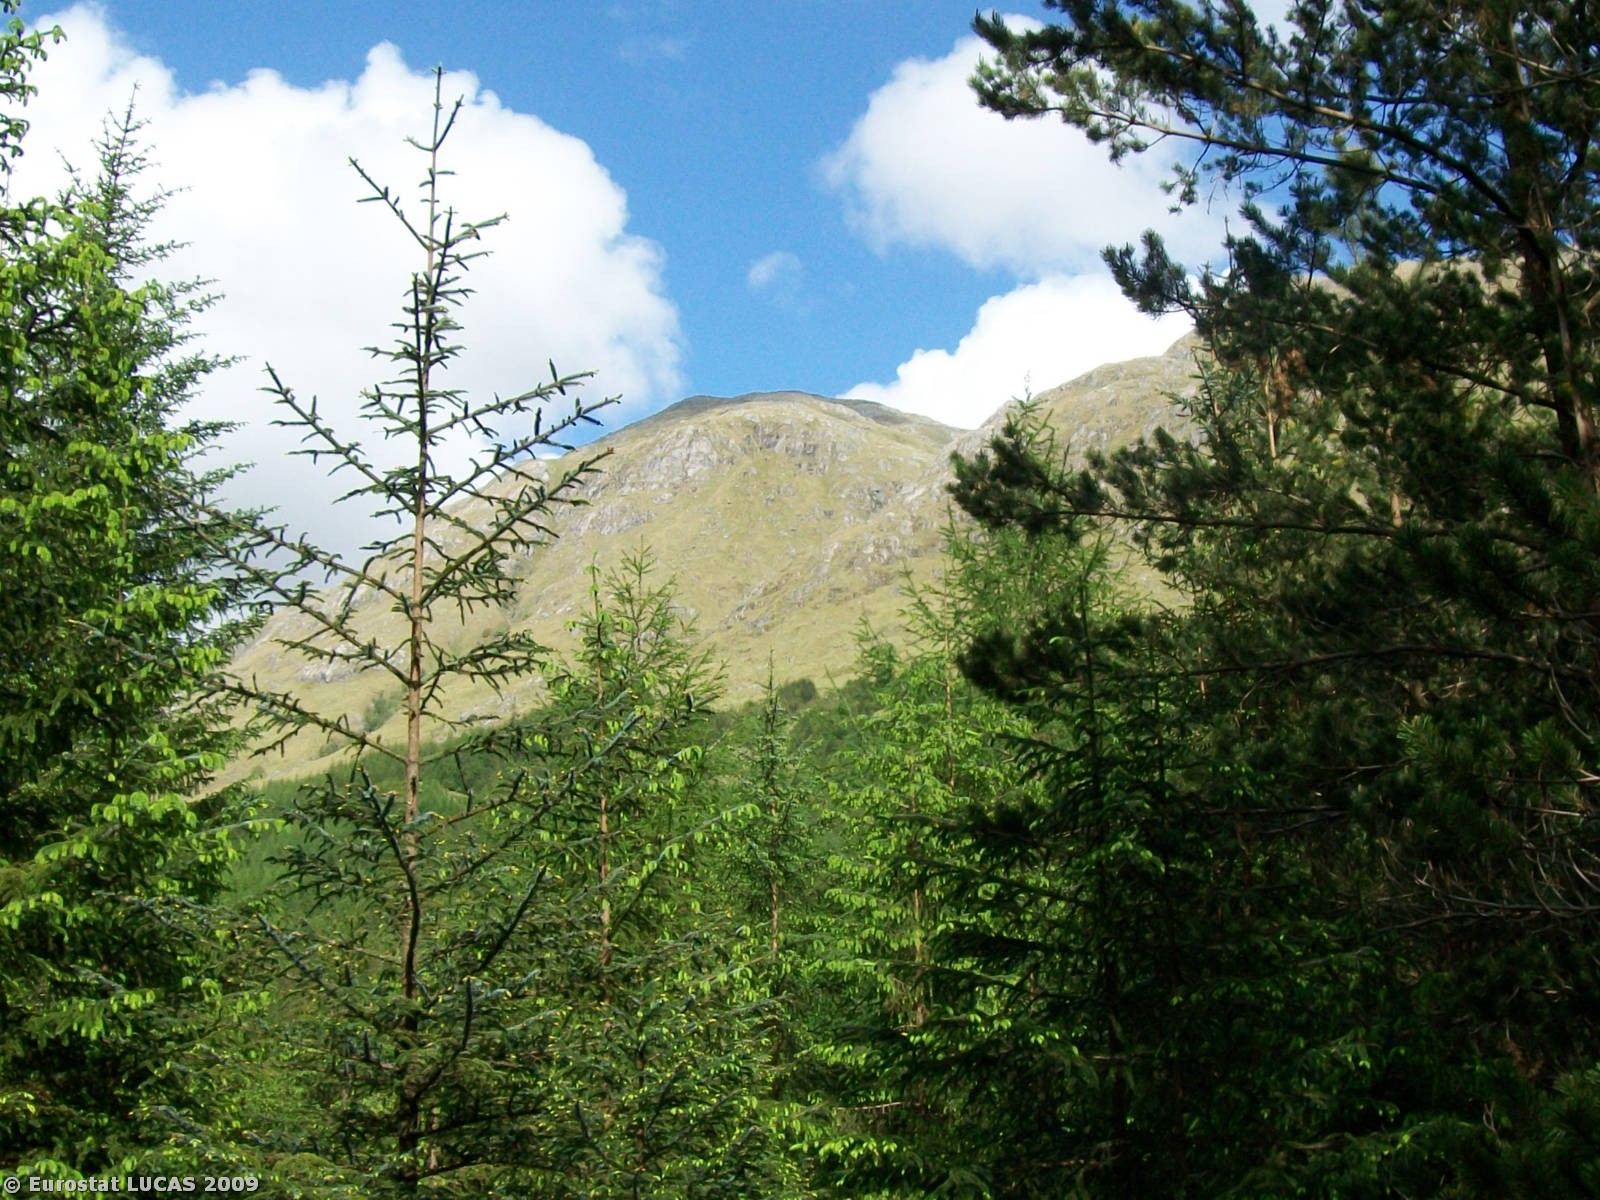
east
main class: Shrubland
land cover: Shrubland without tree cover
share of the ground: 25 - 50 %
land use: Forestry
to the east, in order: Shrubland without tree cover; Coniferous woodland; Grass margins; Paved roads, cycling and walking lanes; Grass margins; Grassland without tree/shrub cover; Bare land; Inland running water; Grassland with sparse tree/shrub cover
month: May
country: GB
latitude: 56.8974
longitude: -5.4341
